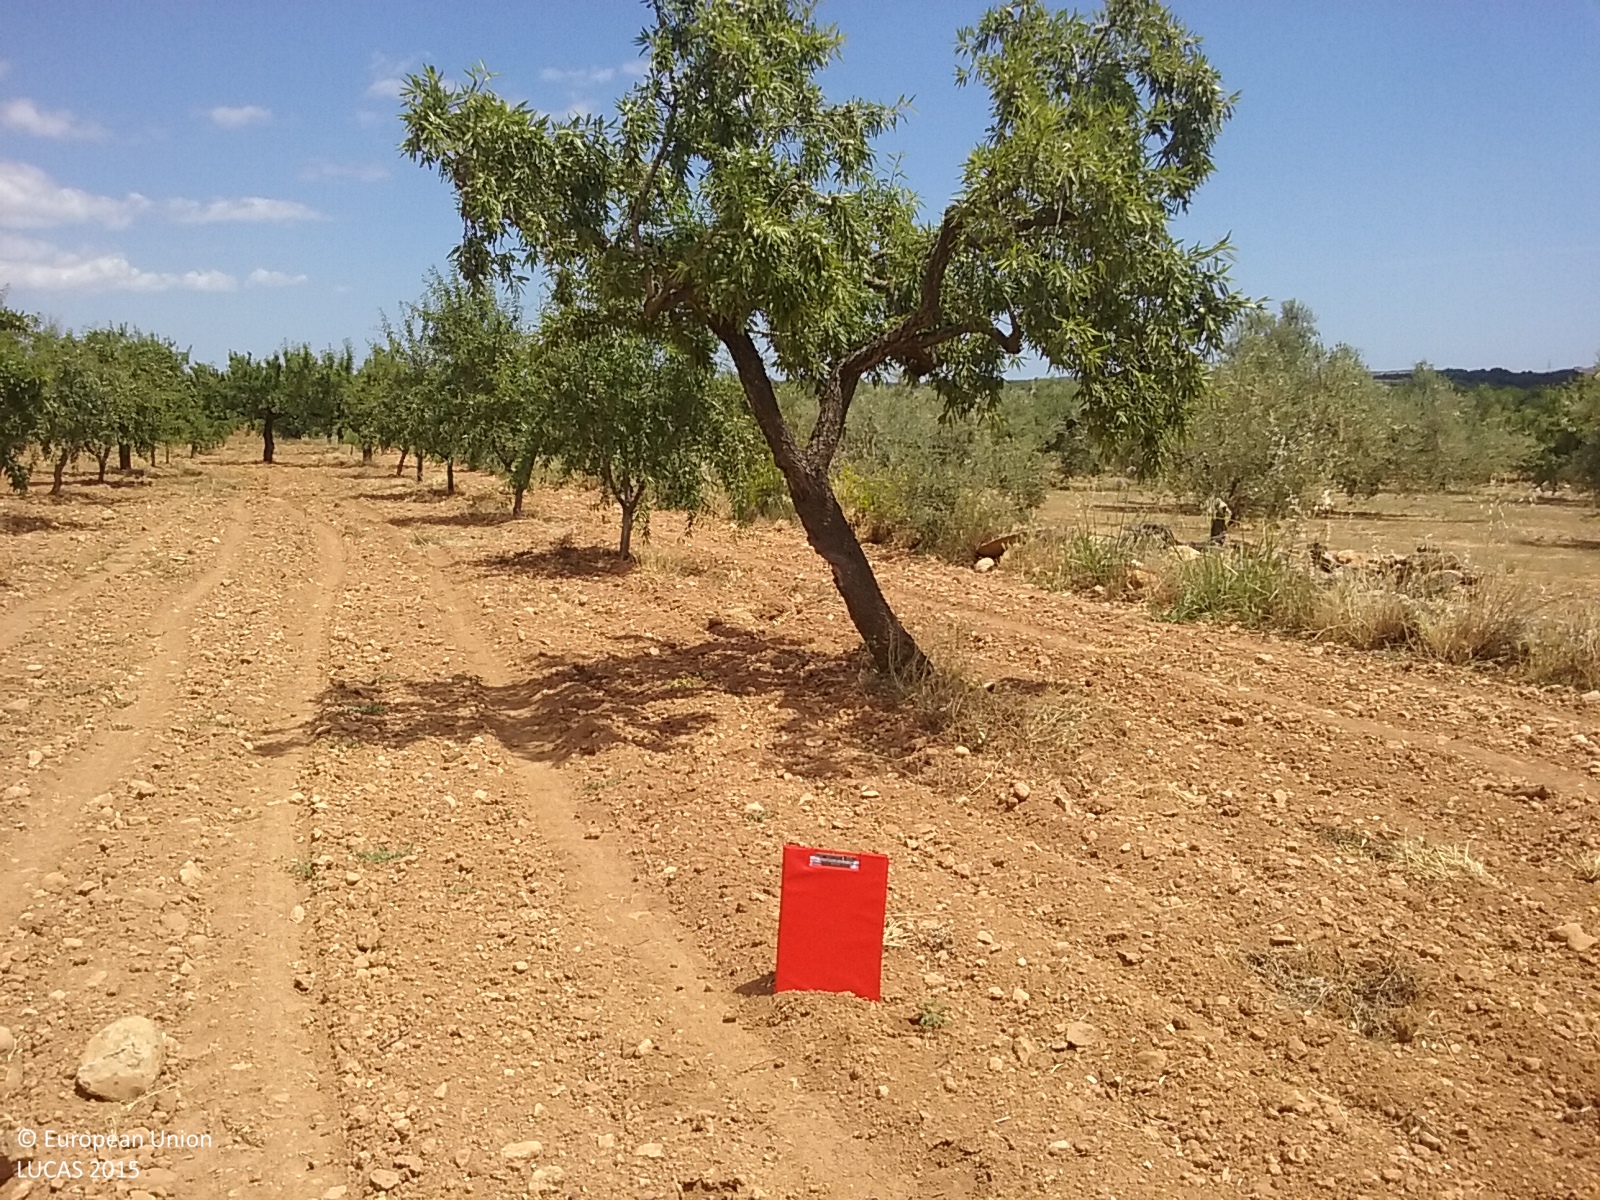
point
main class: Cropland
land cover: Nuts trees
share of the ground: 10 - 25 %
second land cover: Other bare soil
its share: > 75 %
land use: Agriculture (excluding fallow land and kitchen gardens)
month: May
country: ES
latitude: 40.2307
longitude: 0.0187
